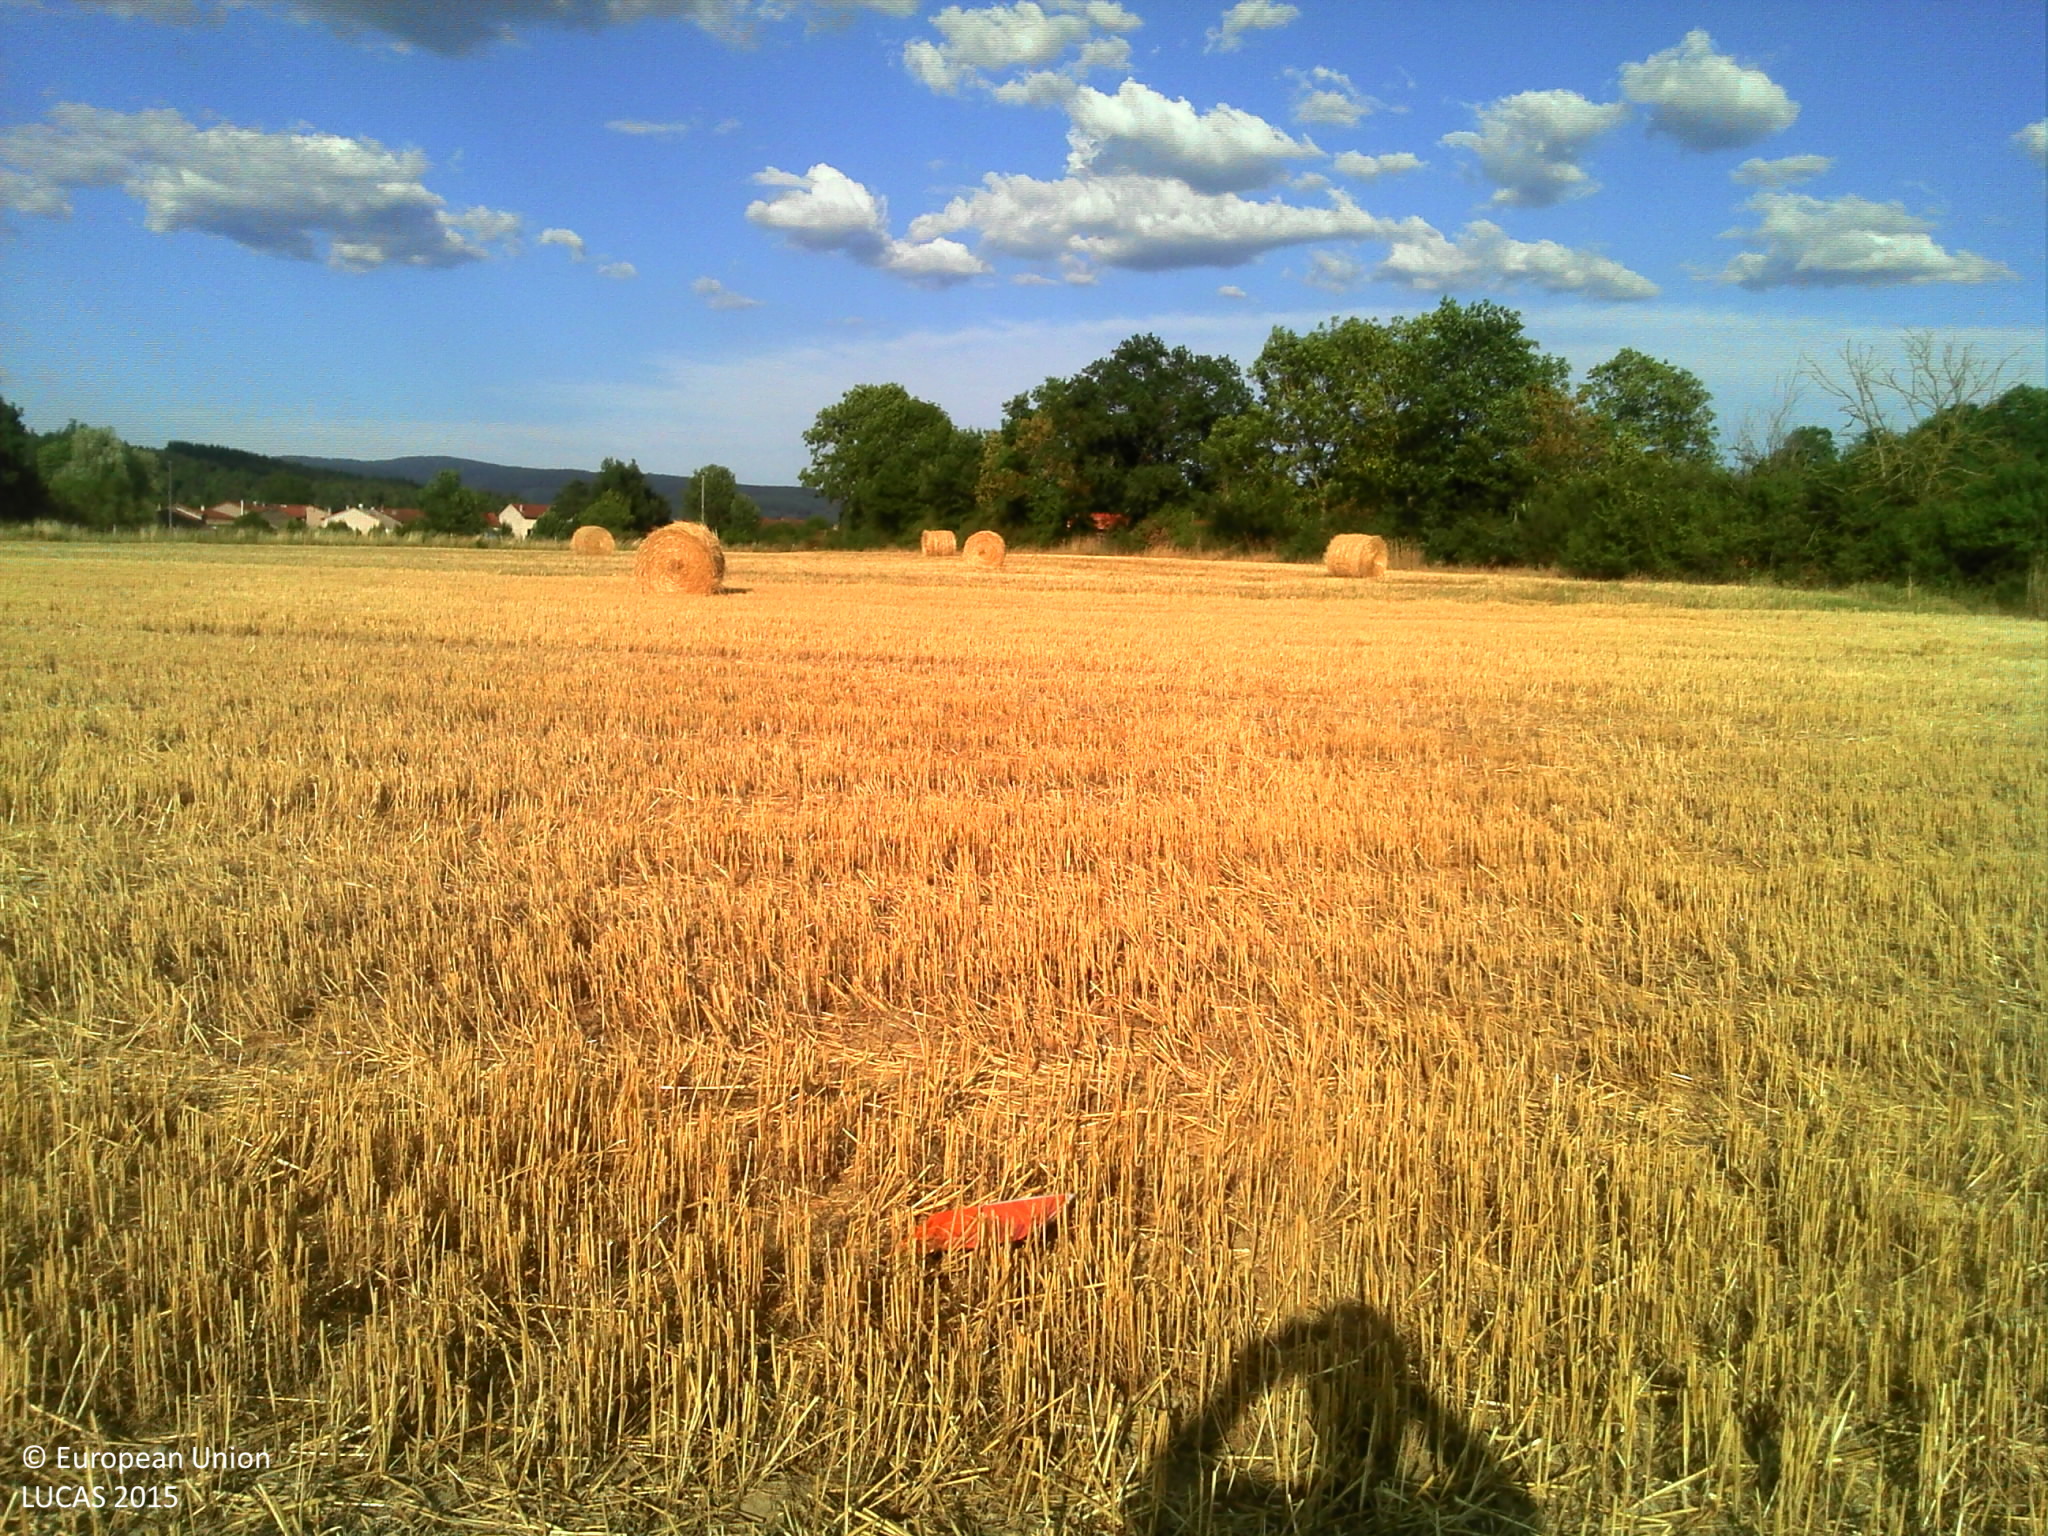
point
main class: Cropland
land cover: Durum wheat
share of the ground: > 75 %
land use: Agriculture (excluding fallow land and kitchen gardens)
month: July
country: FR
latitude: 45.2298
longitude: 3.4686
